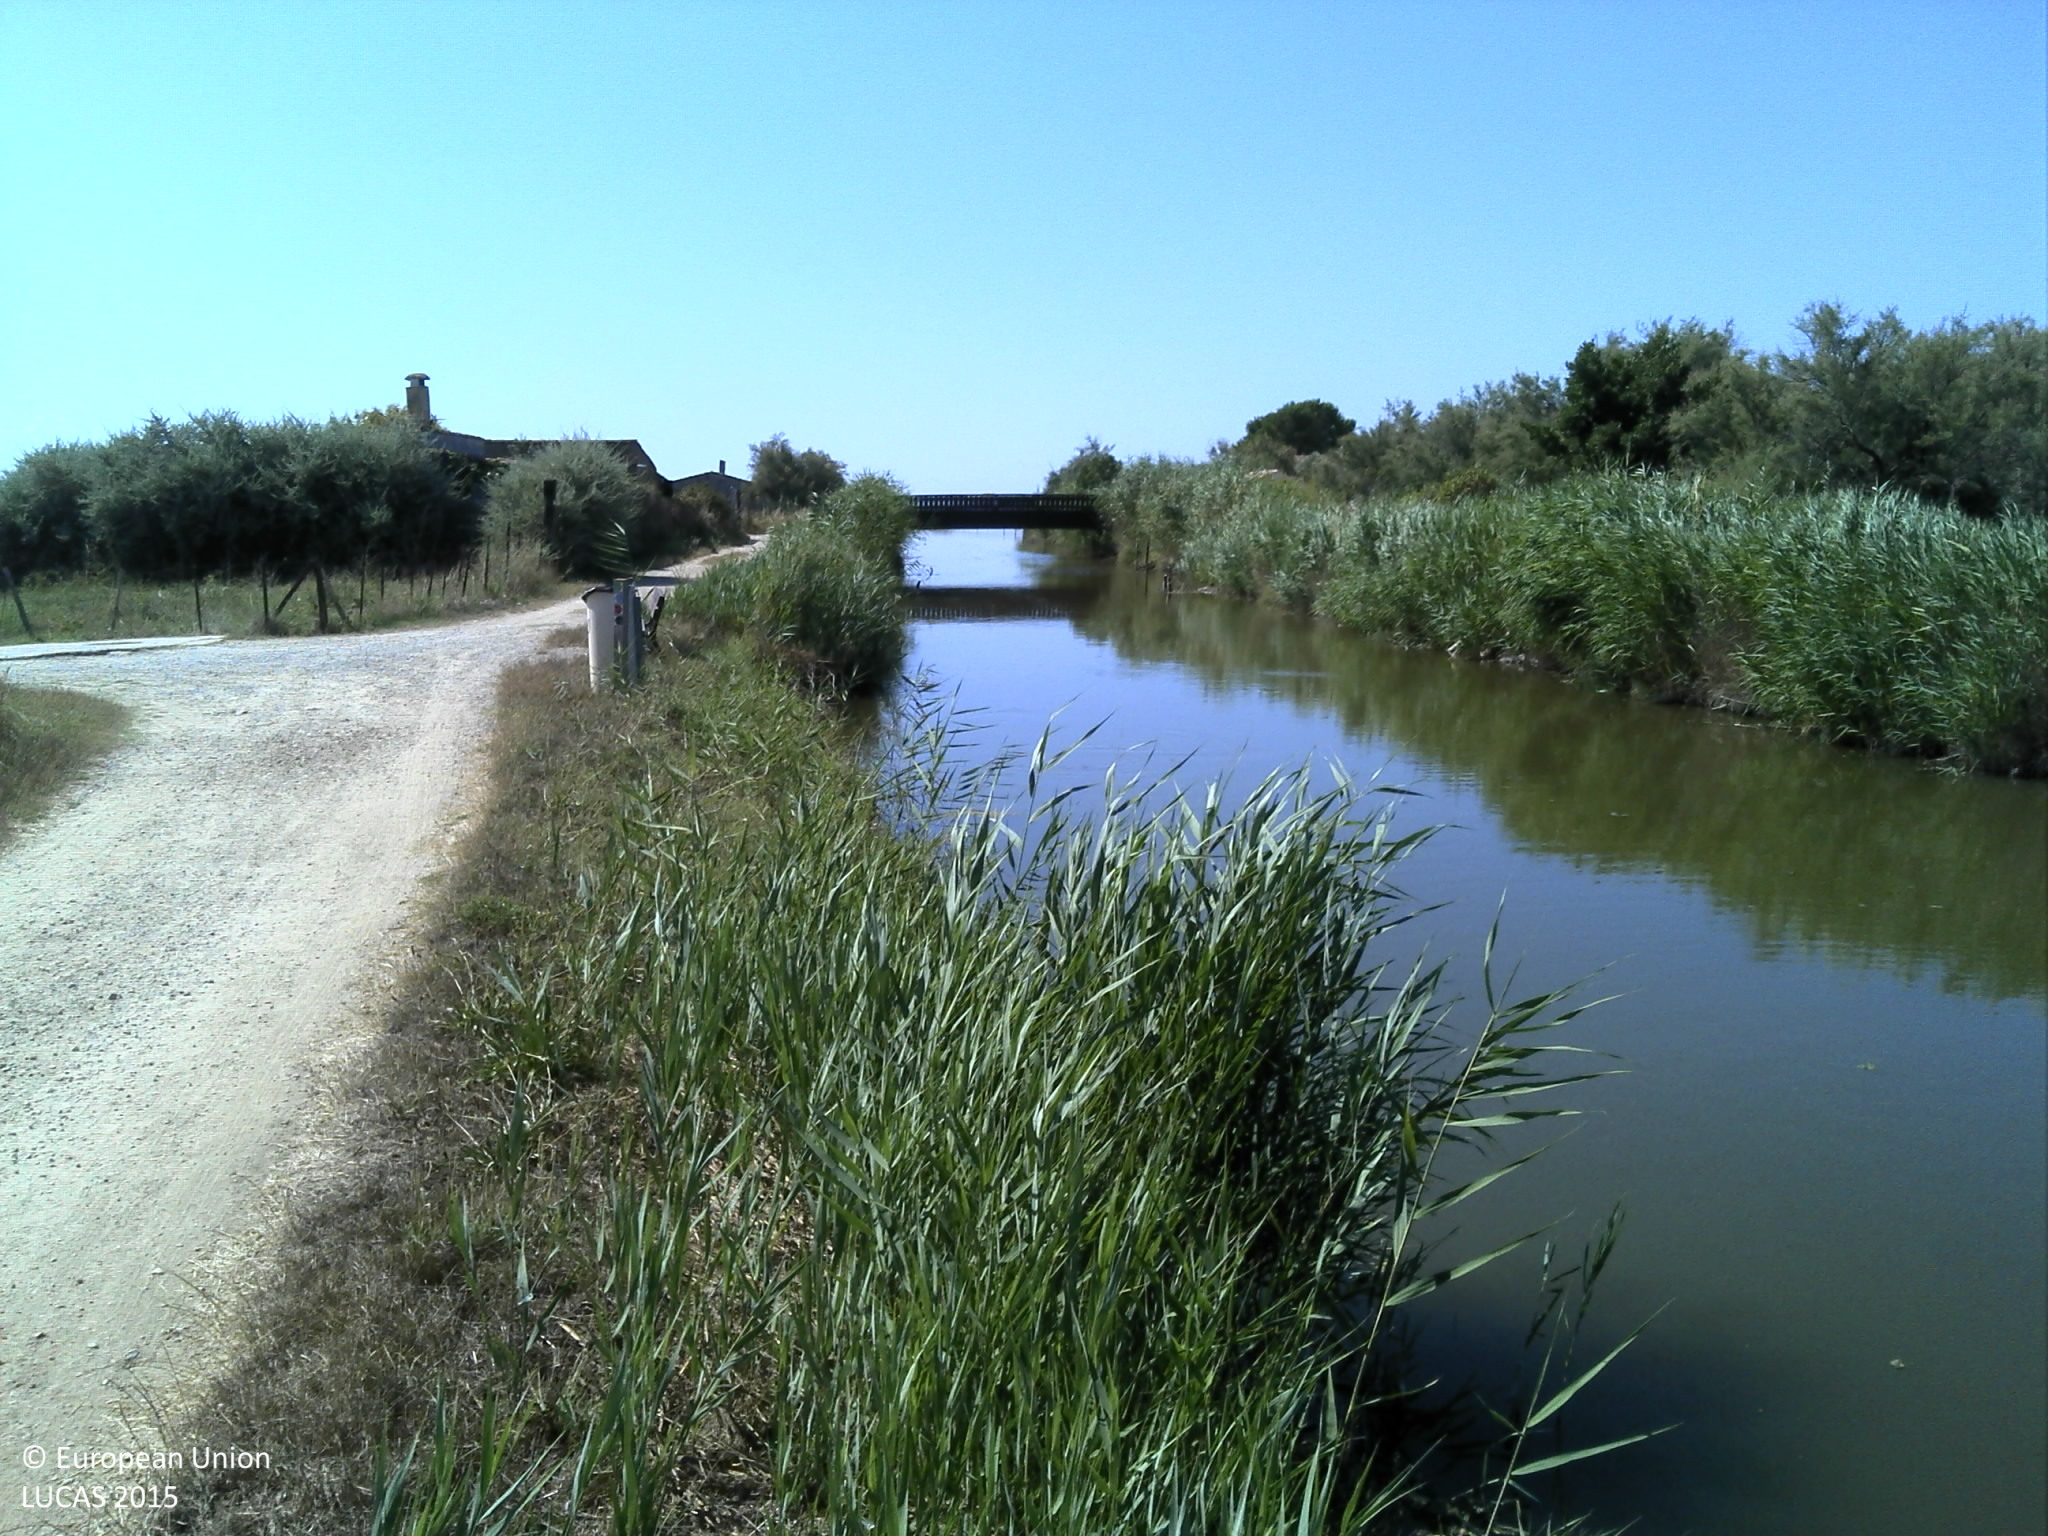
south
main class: Grassland
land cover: Spontaneously vegetated surfaces
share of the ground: > 75 %
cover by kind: herbaceous plants 100 %
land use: Semi-natural and natural areas not in use
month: July
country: FR
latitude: 43.5997
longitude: 4.0260
